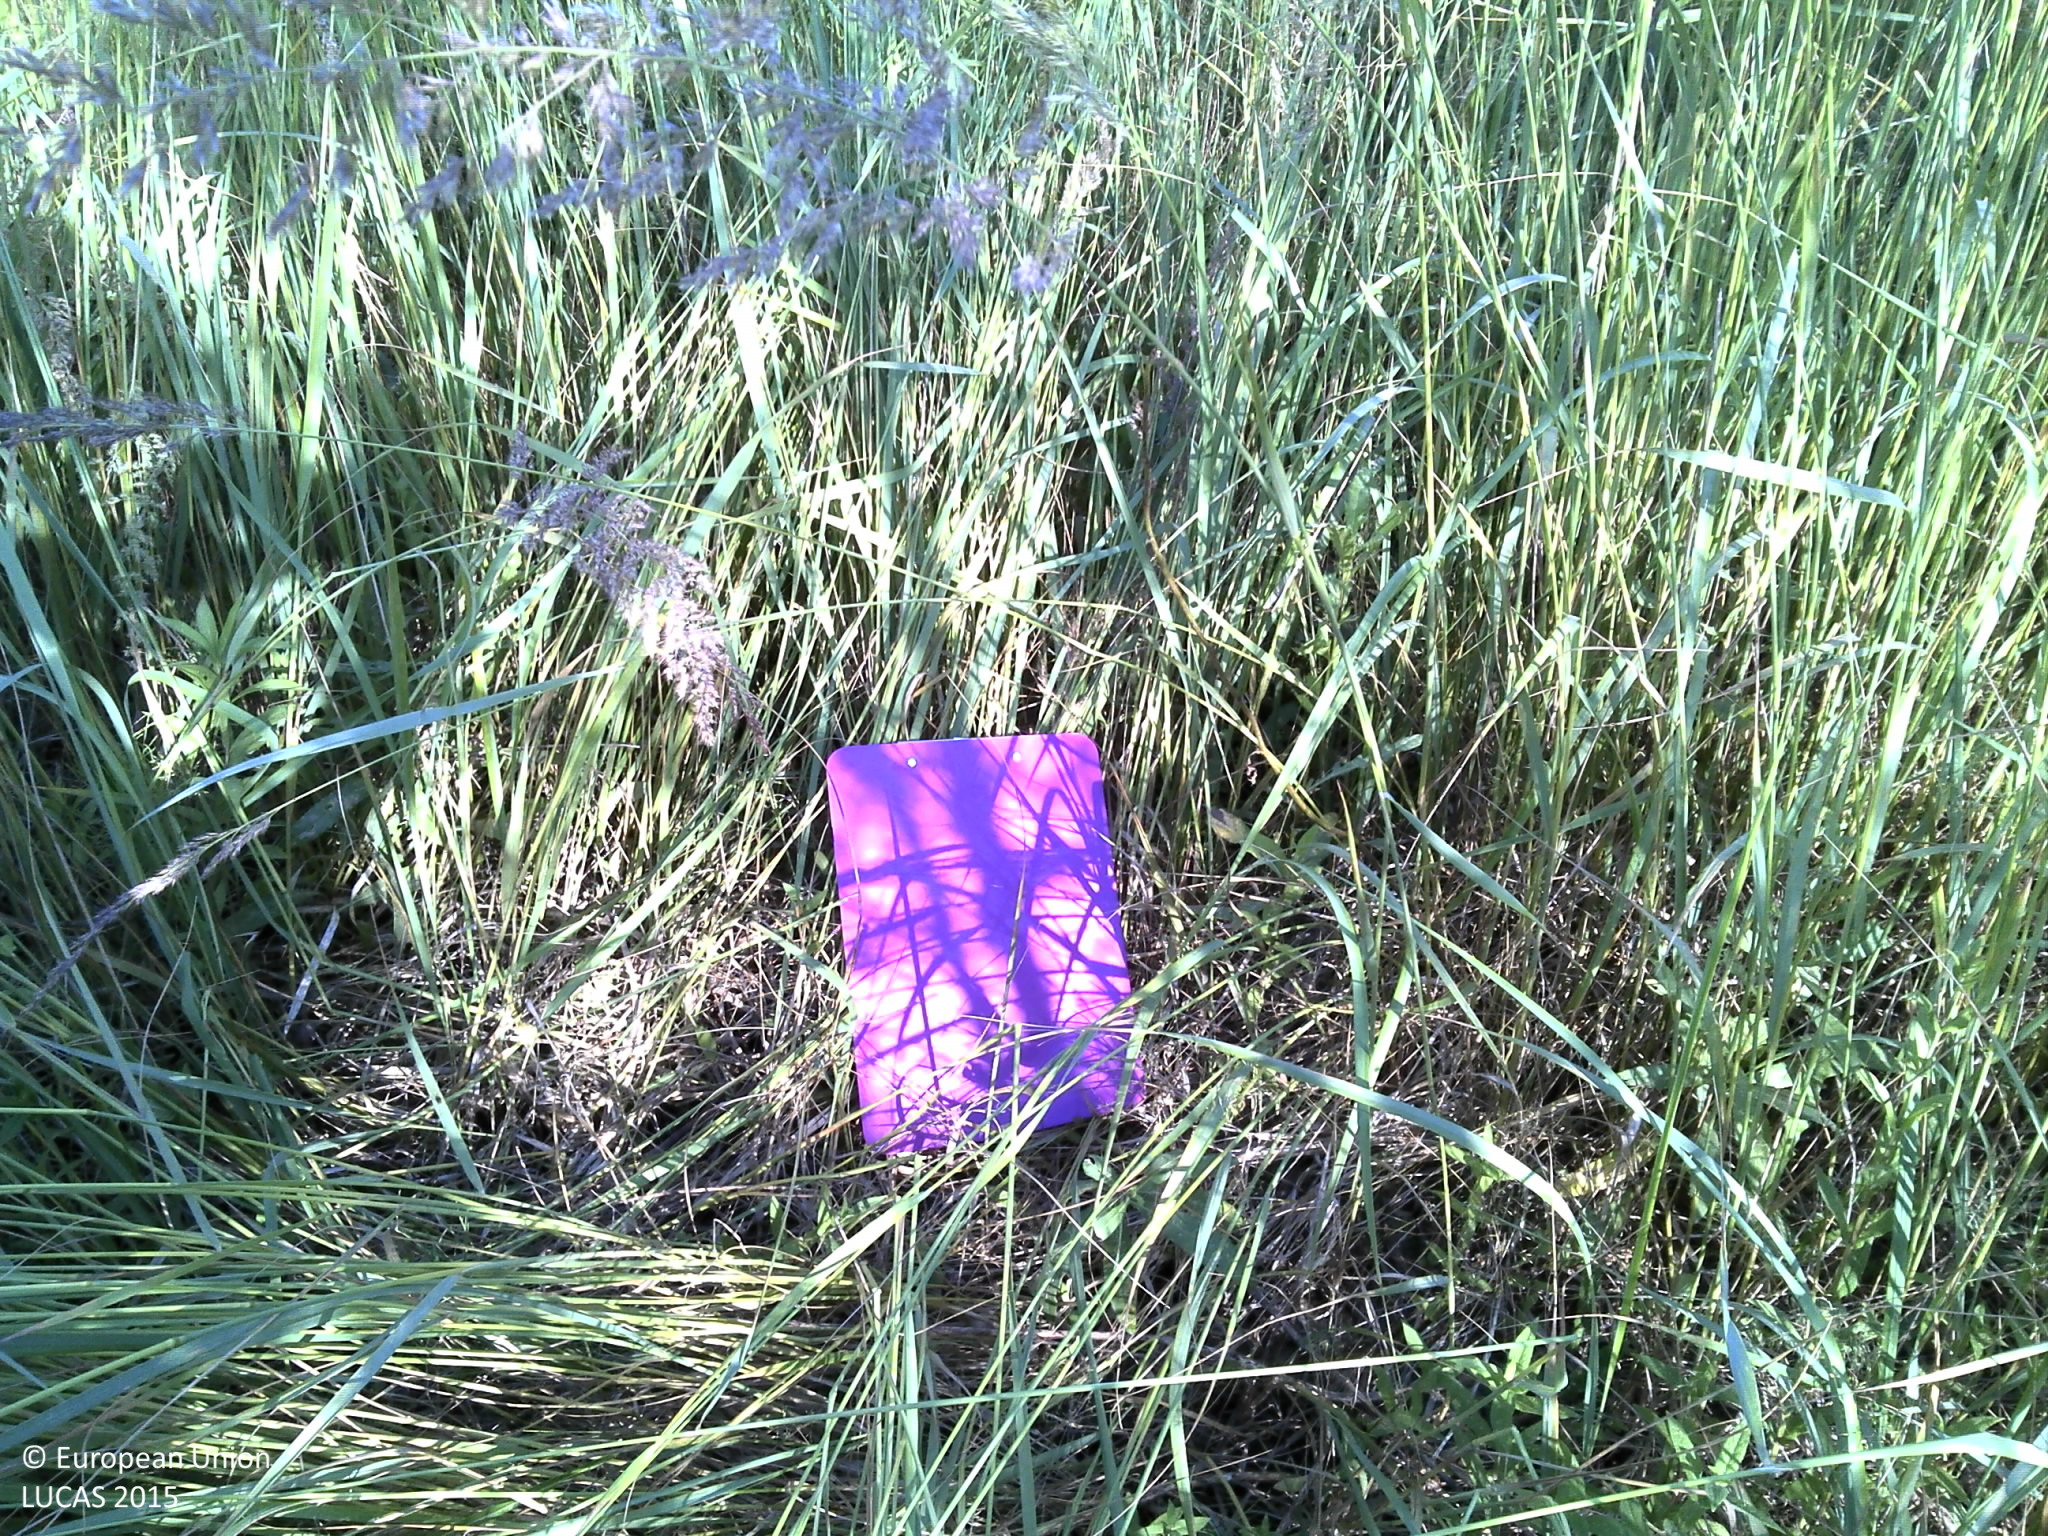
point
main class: Grassland
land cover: Grassland without tree/shrub cover
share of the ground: > 75 %
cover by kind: herbaceous plants 100 %
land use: Semi-natural and natural areas not in use
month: June
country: HR
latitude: 45.6174
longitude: 18.4579
